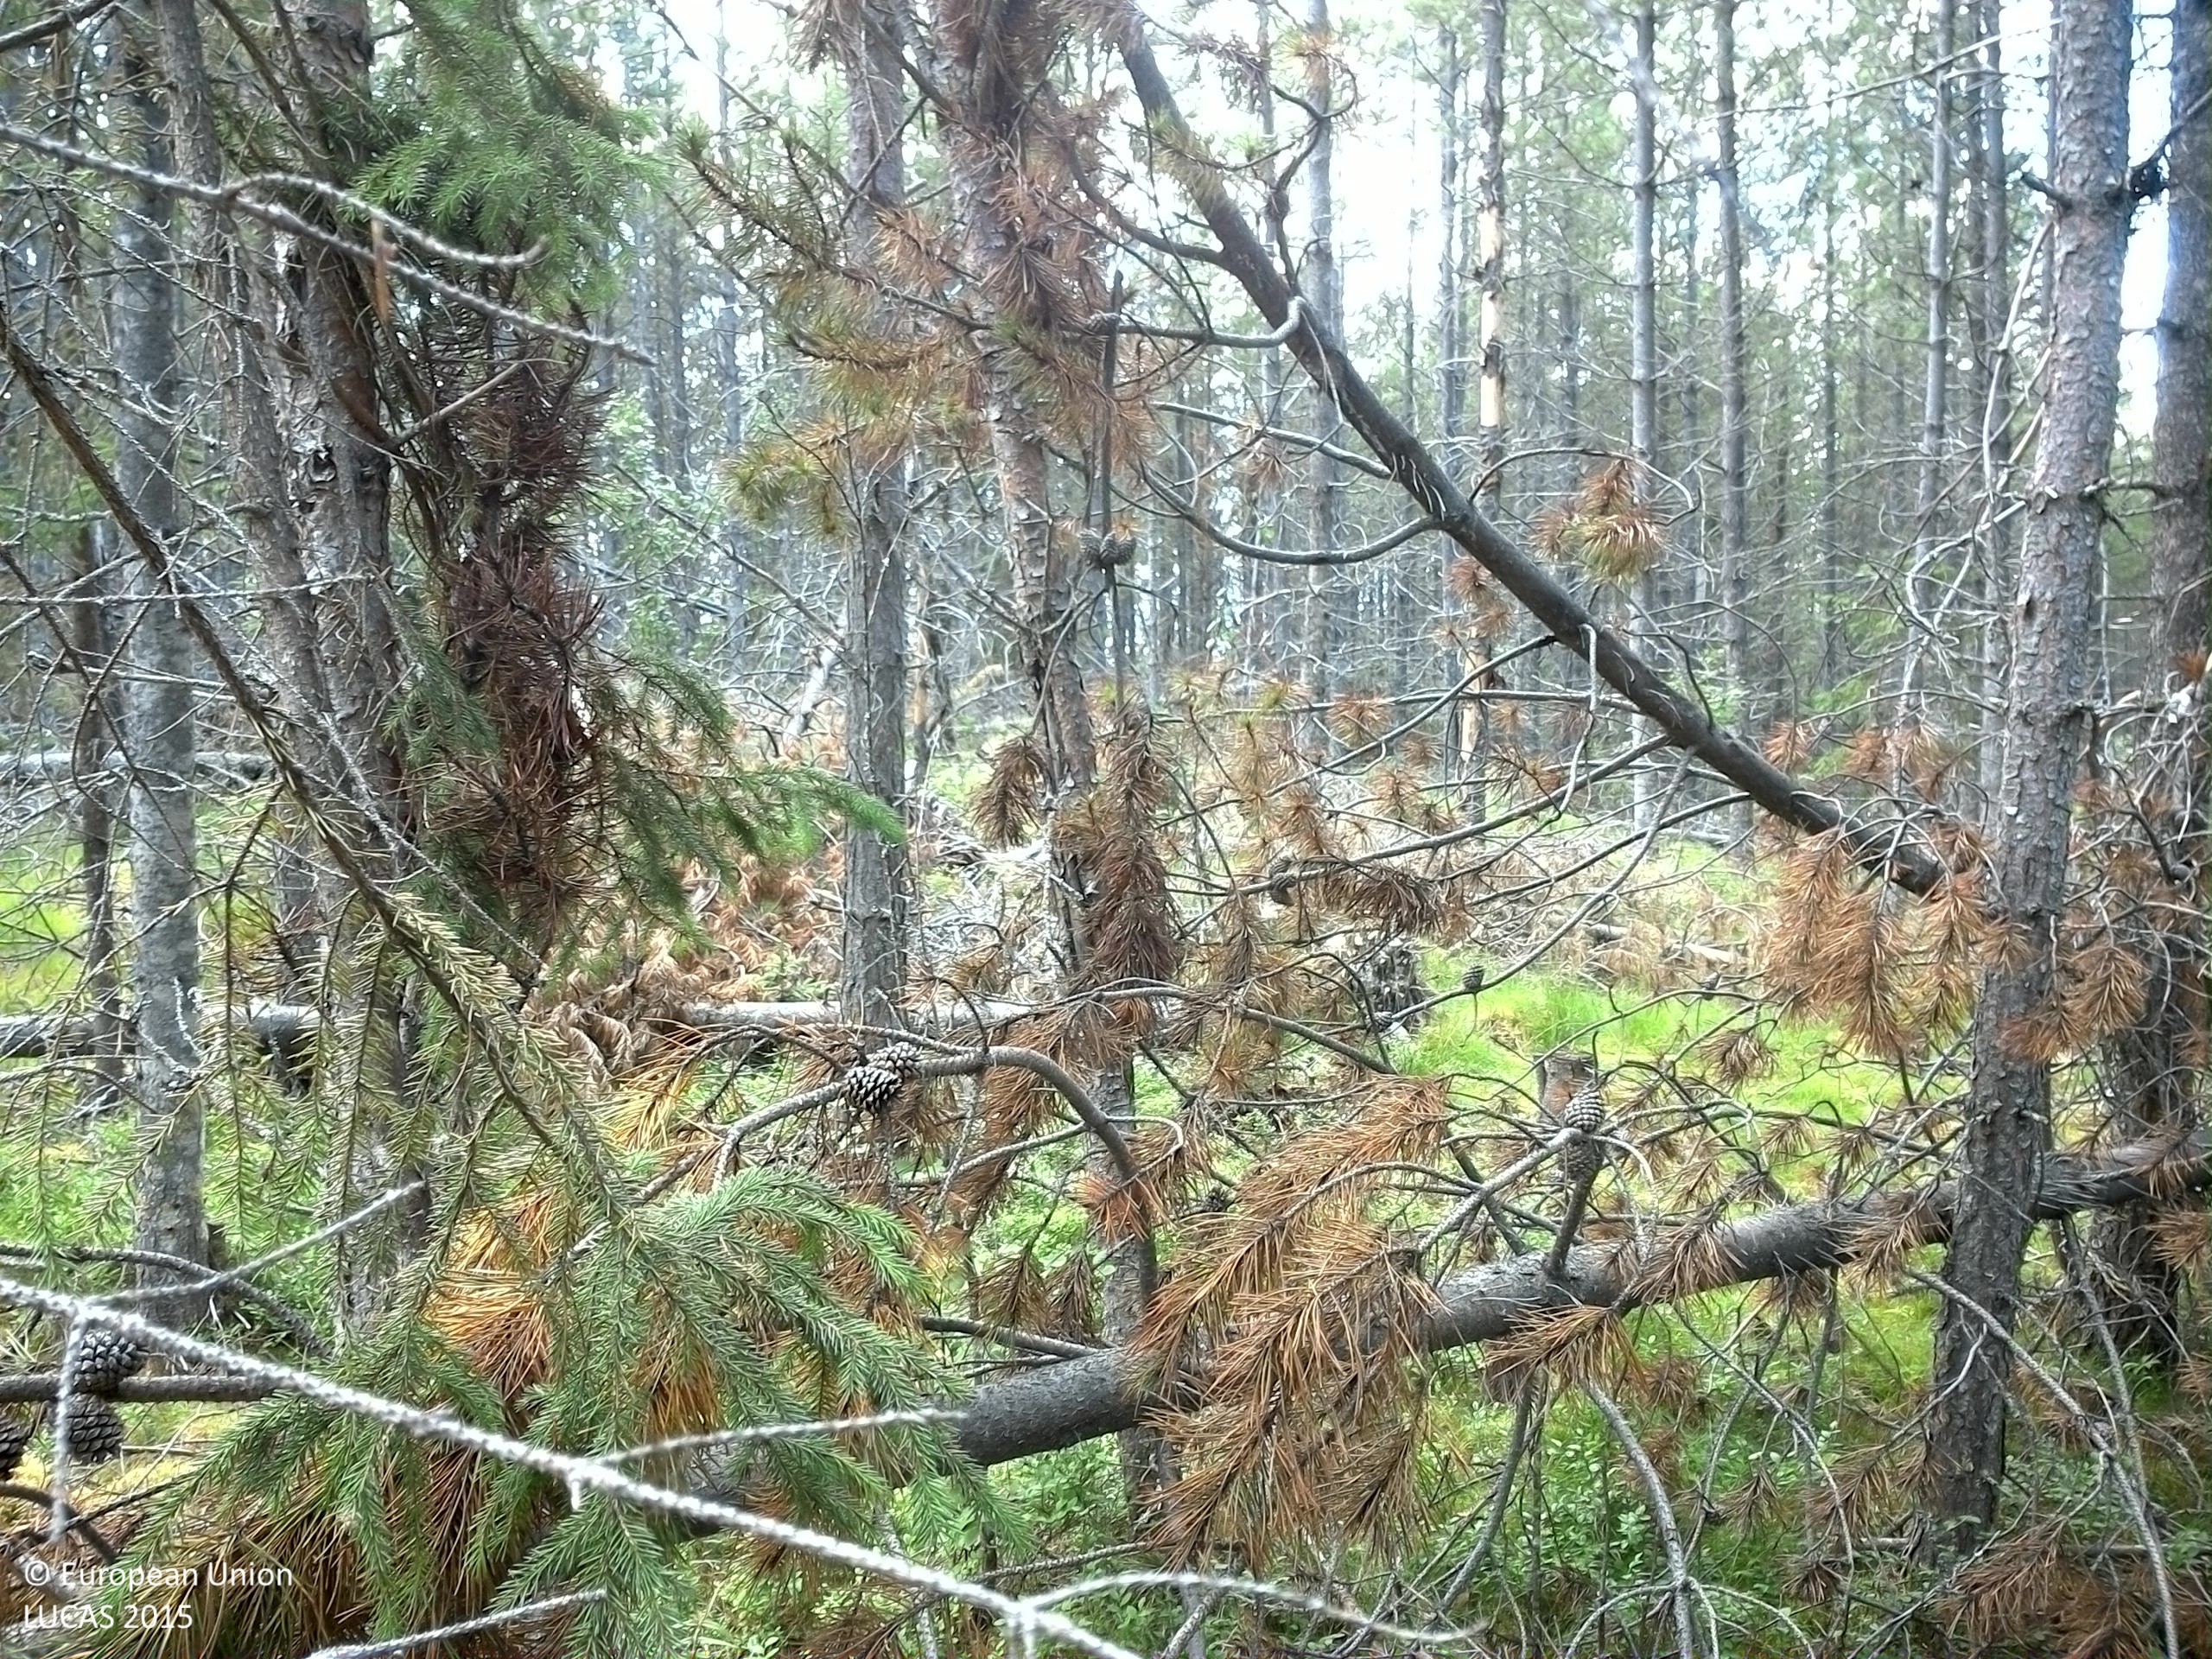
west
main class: Woodland
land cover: Pine dominated coniferous woodland
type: exotic forest
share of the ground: > 75 %
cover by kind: coniferous forest trees 75 %, herbaceous plants 10 %, lichens and mosses 10 %, shrubs 5 %
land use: Forestry
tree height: > 5 m
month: August
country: SE
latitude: 62.9034
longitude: 16.5694
